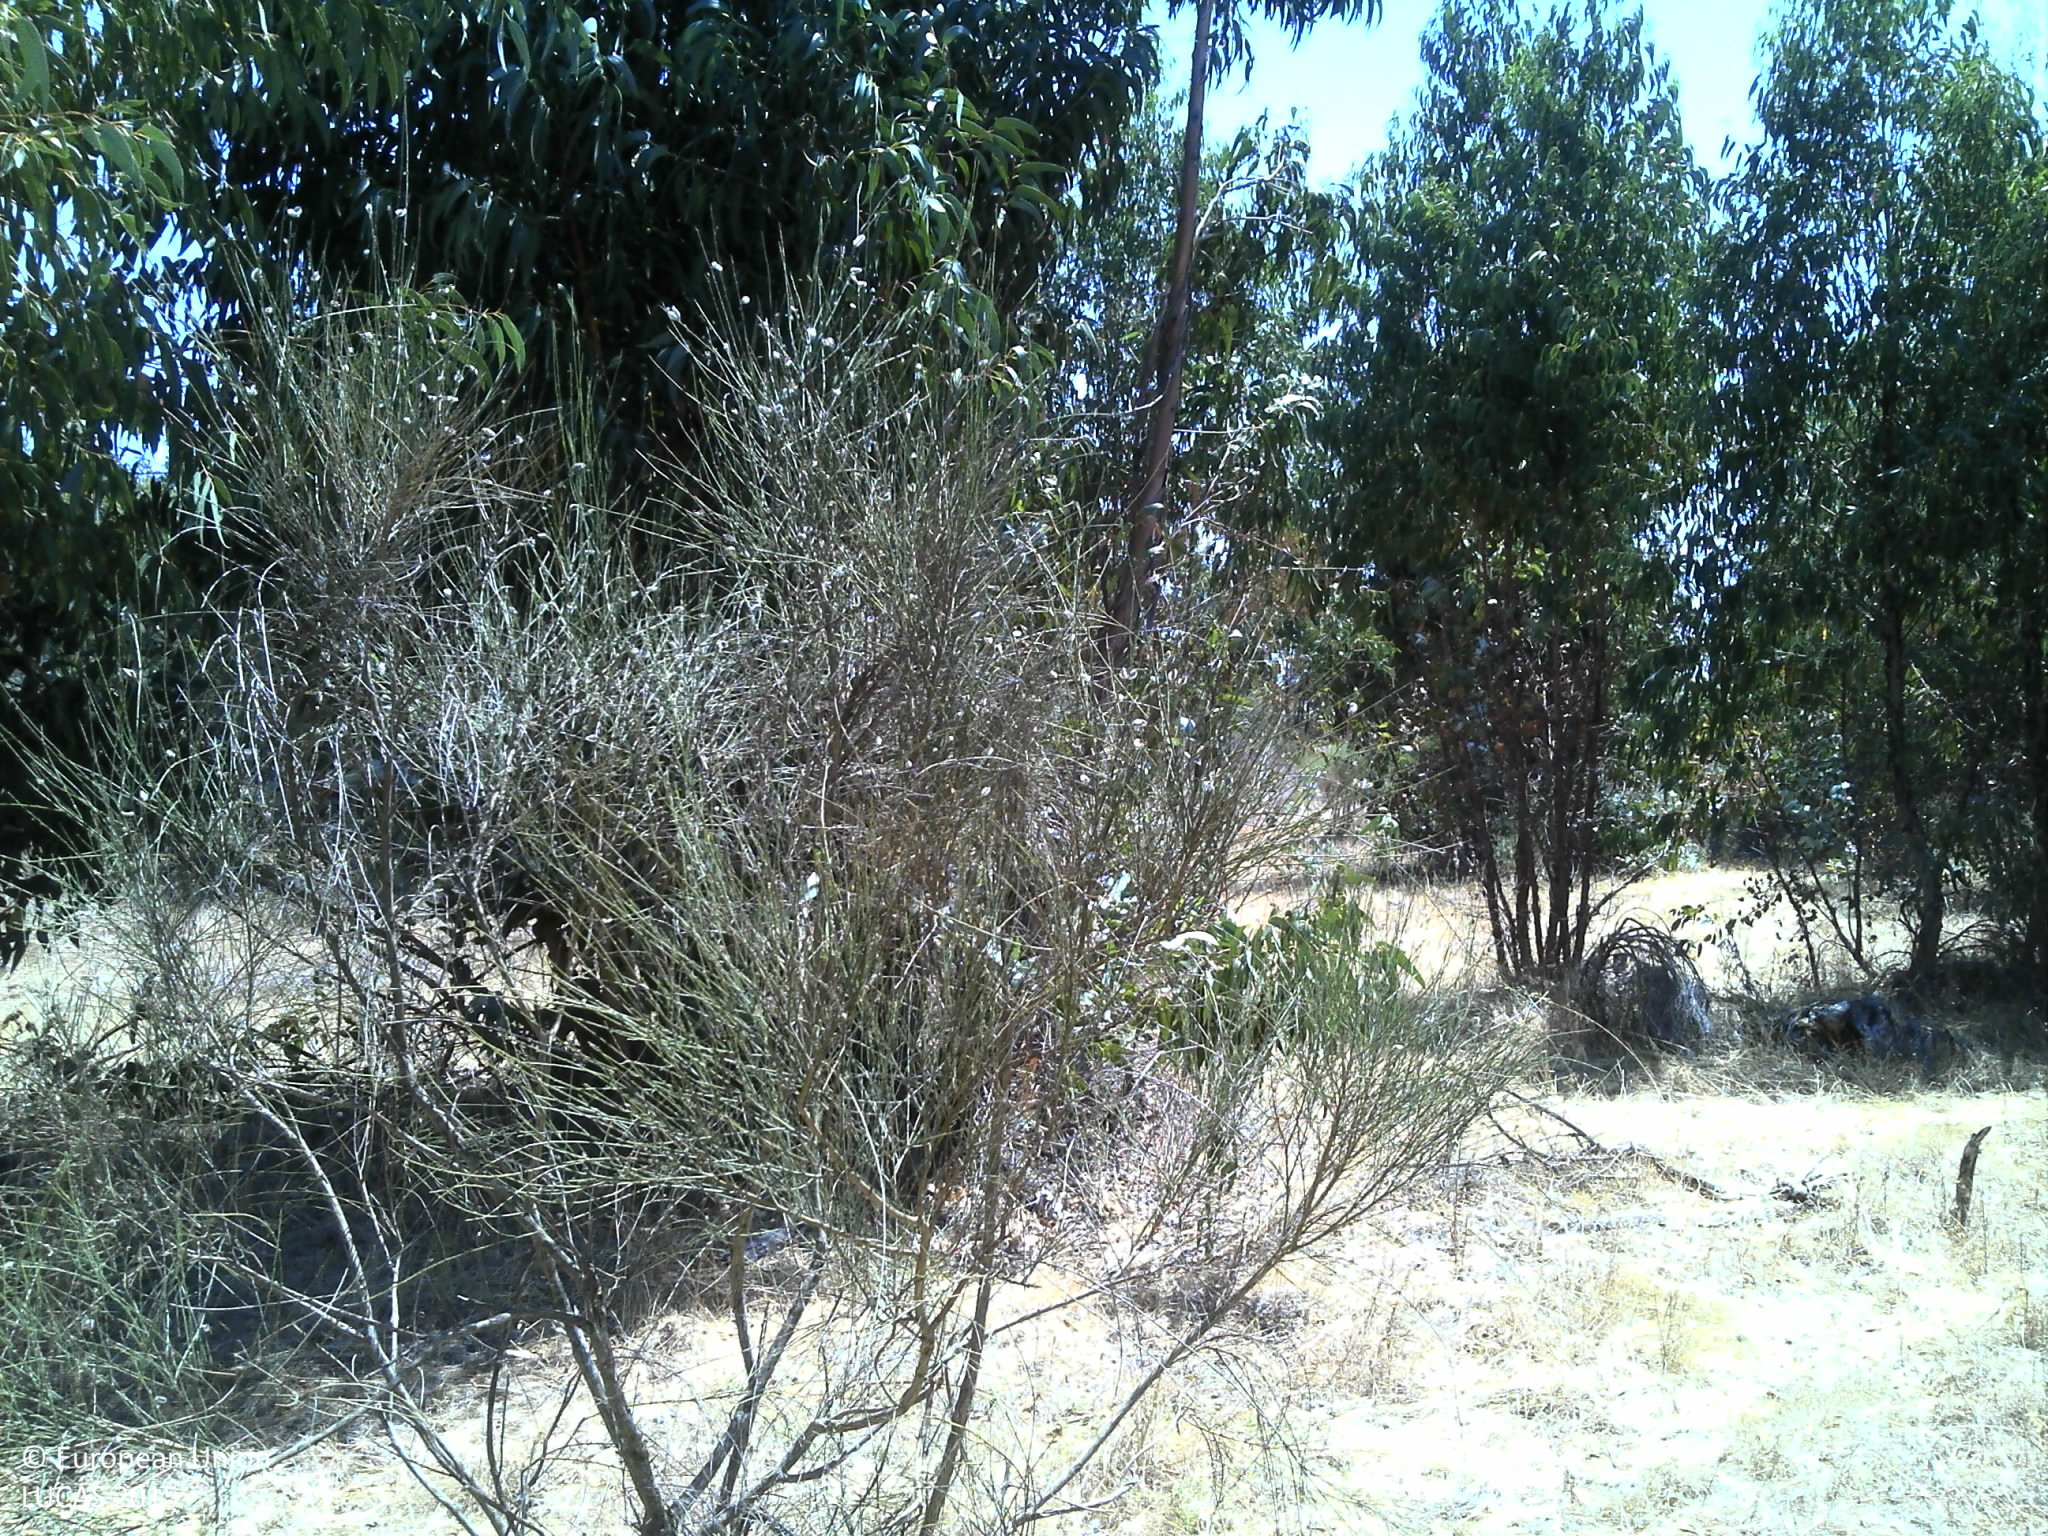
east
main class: Woodland
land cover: Broadleaved woodland
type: broadleaved evergreen forest
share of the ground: 25 - 50 %
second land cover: Grassland without tree/shrub cover
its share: 25 - 50 %
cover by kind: unconsolidated bare surface 40 %, broadleaved forest trees 30 %, herbaceous plants 25 %, shrubs 5 %
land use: Forestry
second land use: Agriculture (excluding fallow land and kitchen gardens)
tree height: > 5 m
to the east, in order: Broadleaved woodland; Grassland without tree/shrub cover; Broadleaved woodland; Tracks; Broadleaved woodland
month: July
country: PT
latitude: 39.3592
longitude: -7.7250
